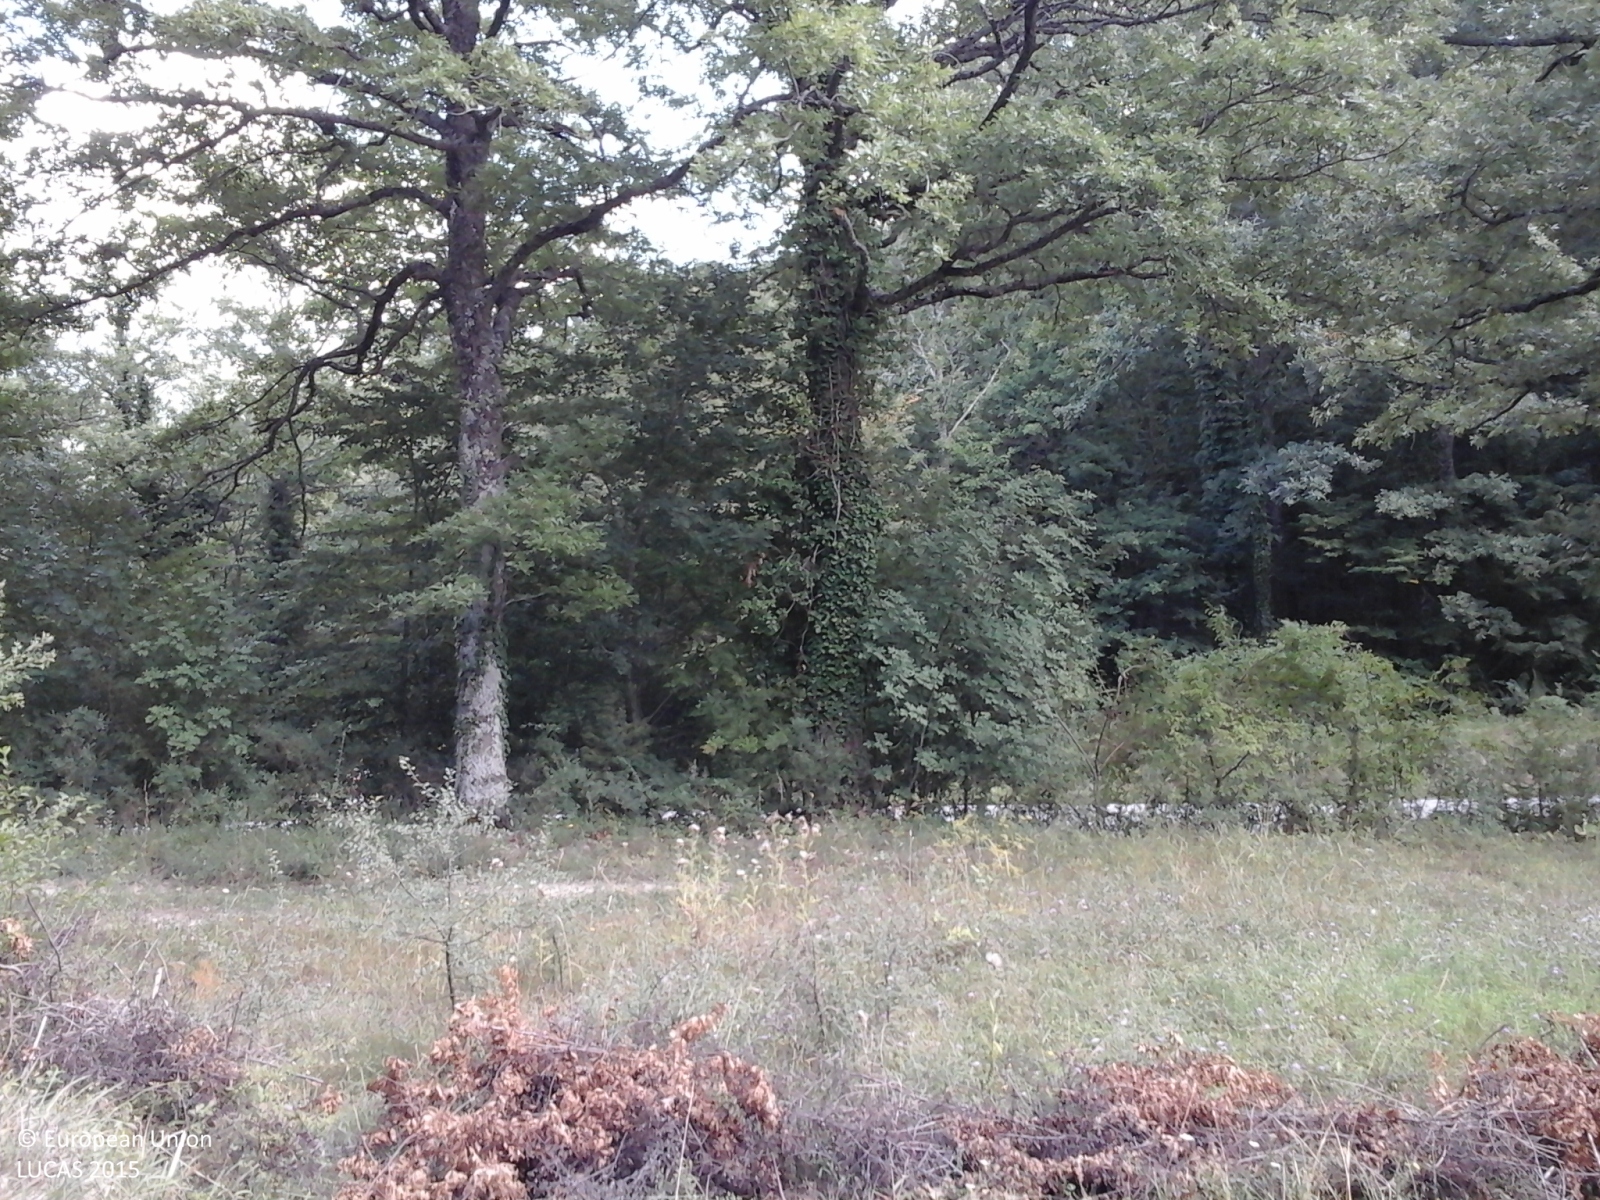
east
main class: Woodland
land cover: Broadleaved woodland
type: thermophilous deciduous forest
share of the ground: > 75 %
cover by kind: broadleaved forest trees 80 %, shrubs 15 %, herbaceous plants 5 %
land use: Semi-natural and natural areas not in use
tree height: > 5 m
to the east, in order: Broadleaved woodland
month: August
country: IT
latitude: 41.8078
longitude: 14.1864
